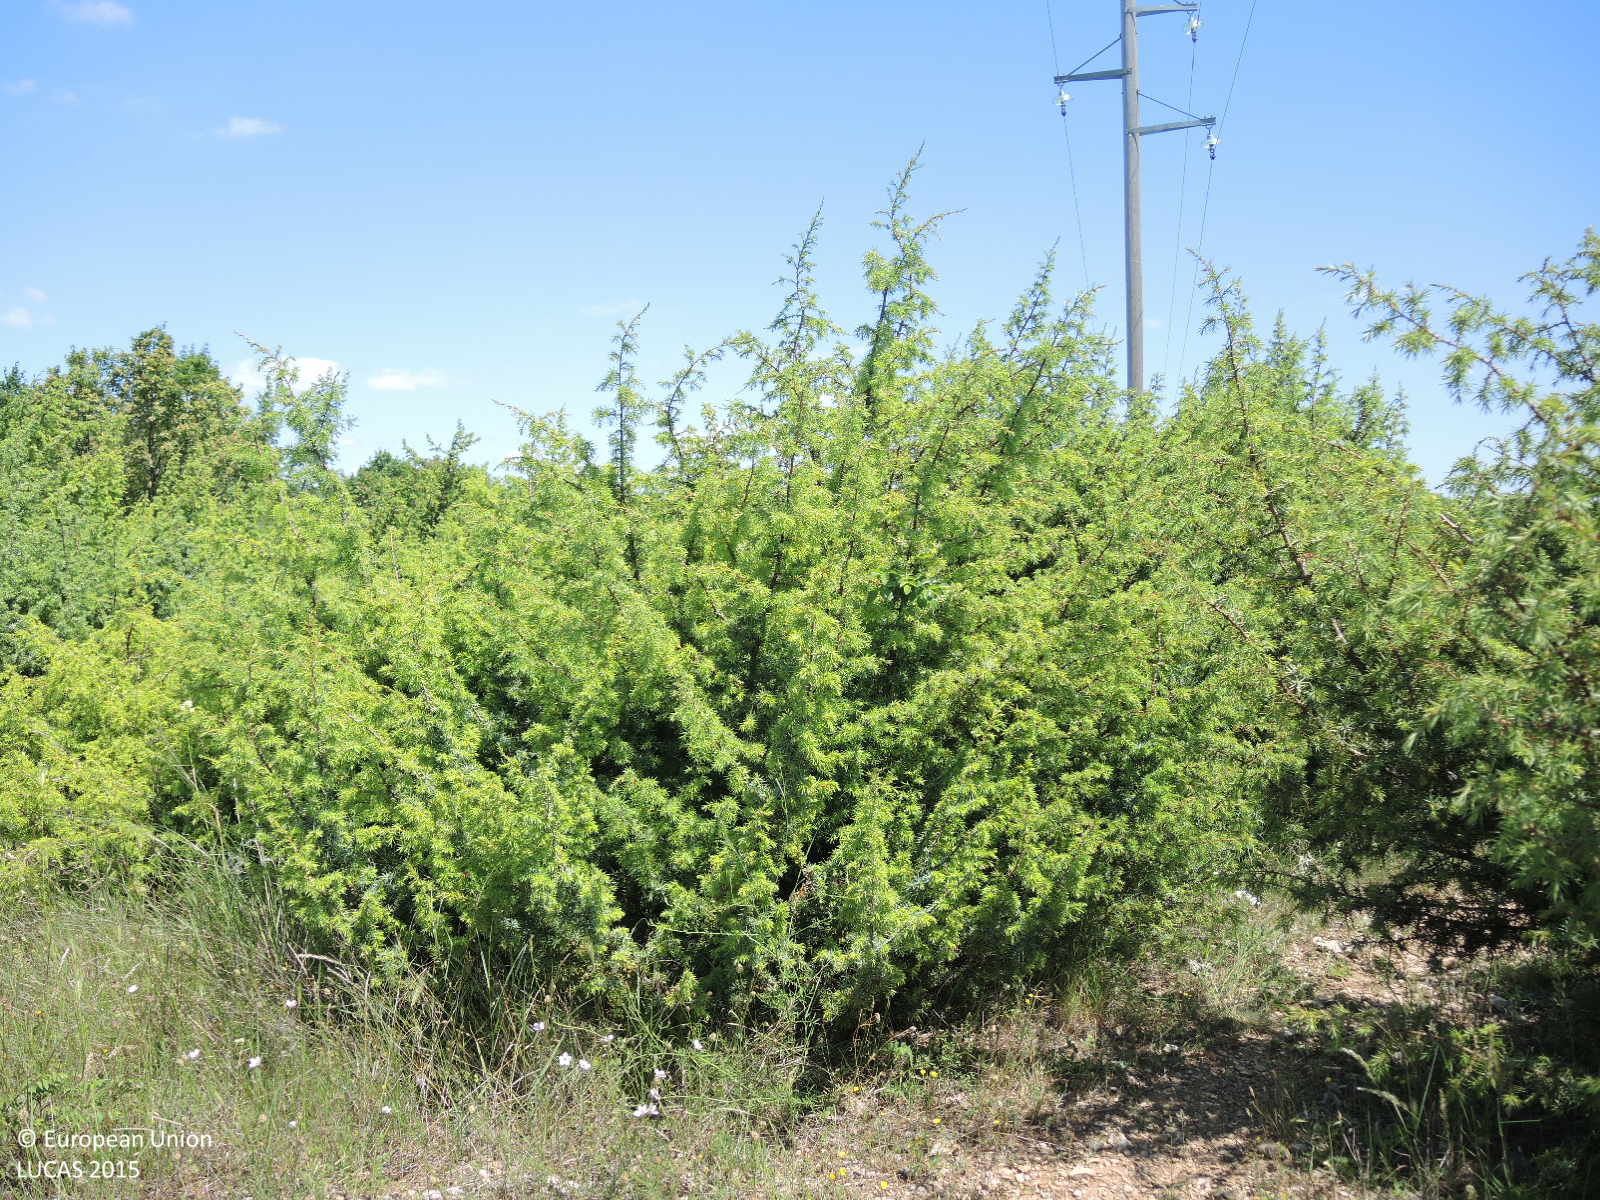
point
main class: Shrubland
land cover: Shrubland without tree cover
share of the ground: 25 - 50 %
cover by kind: shrubs 45 %, herbaceous plants 35 %, unconsolidated bare surface 20 %
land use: Semi-natural and natural areas not in use
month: May
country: HR
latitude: 44.0425
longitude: 15.8201
